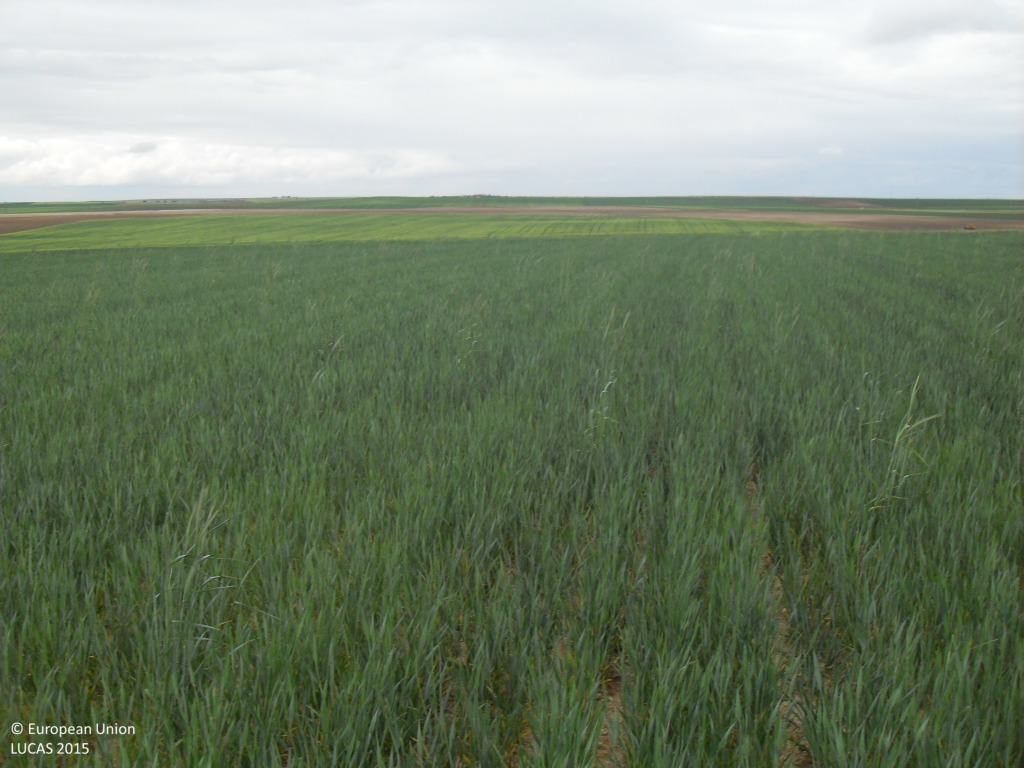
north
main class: Cropland
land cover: Common wheat
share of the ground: > 75 %
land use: Agriculture (excluding fallow land and kitchen gardens)
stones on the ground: 10 - 25 %
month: April
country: ES
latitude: 40.8861
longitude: -5.2475
